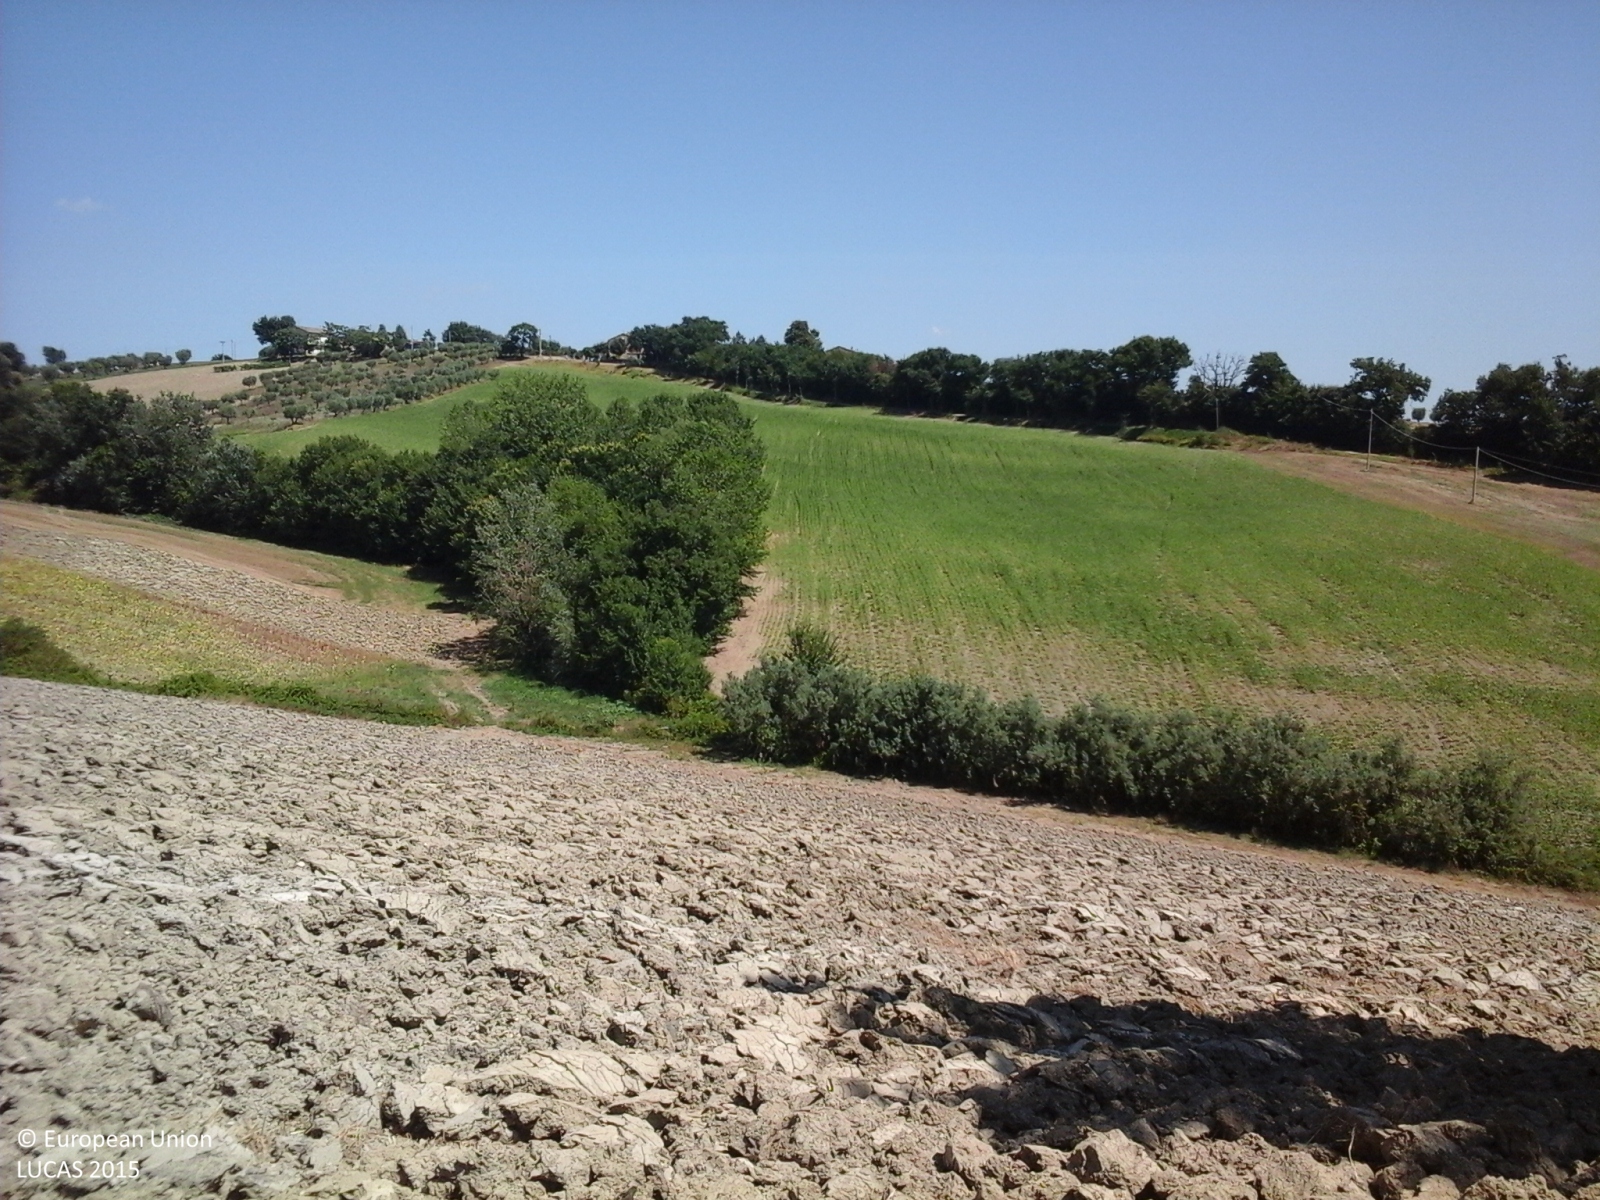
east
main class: Cropland
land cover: Durum wheat
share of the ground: > 75 %
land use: Agriculture (excluding fallow land and kitchen gardens)
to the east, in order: Durum wheat; Grass margins; Abandoned hedges; Ditches and canals; Abandoned hedges; Sunflower
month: August
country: IT
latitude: 43.1736
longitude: 13.4476
